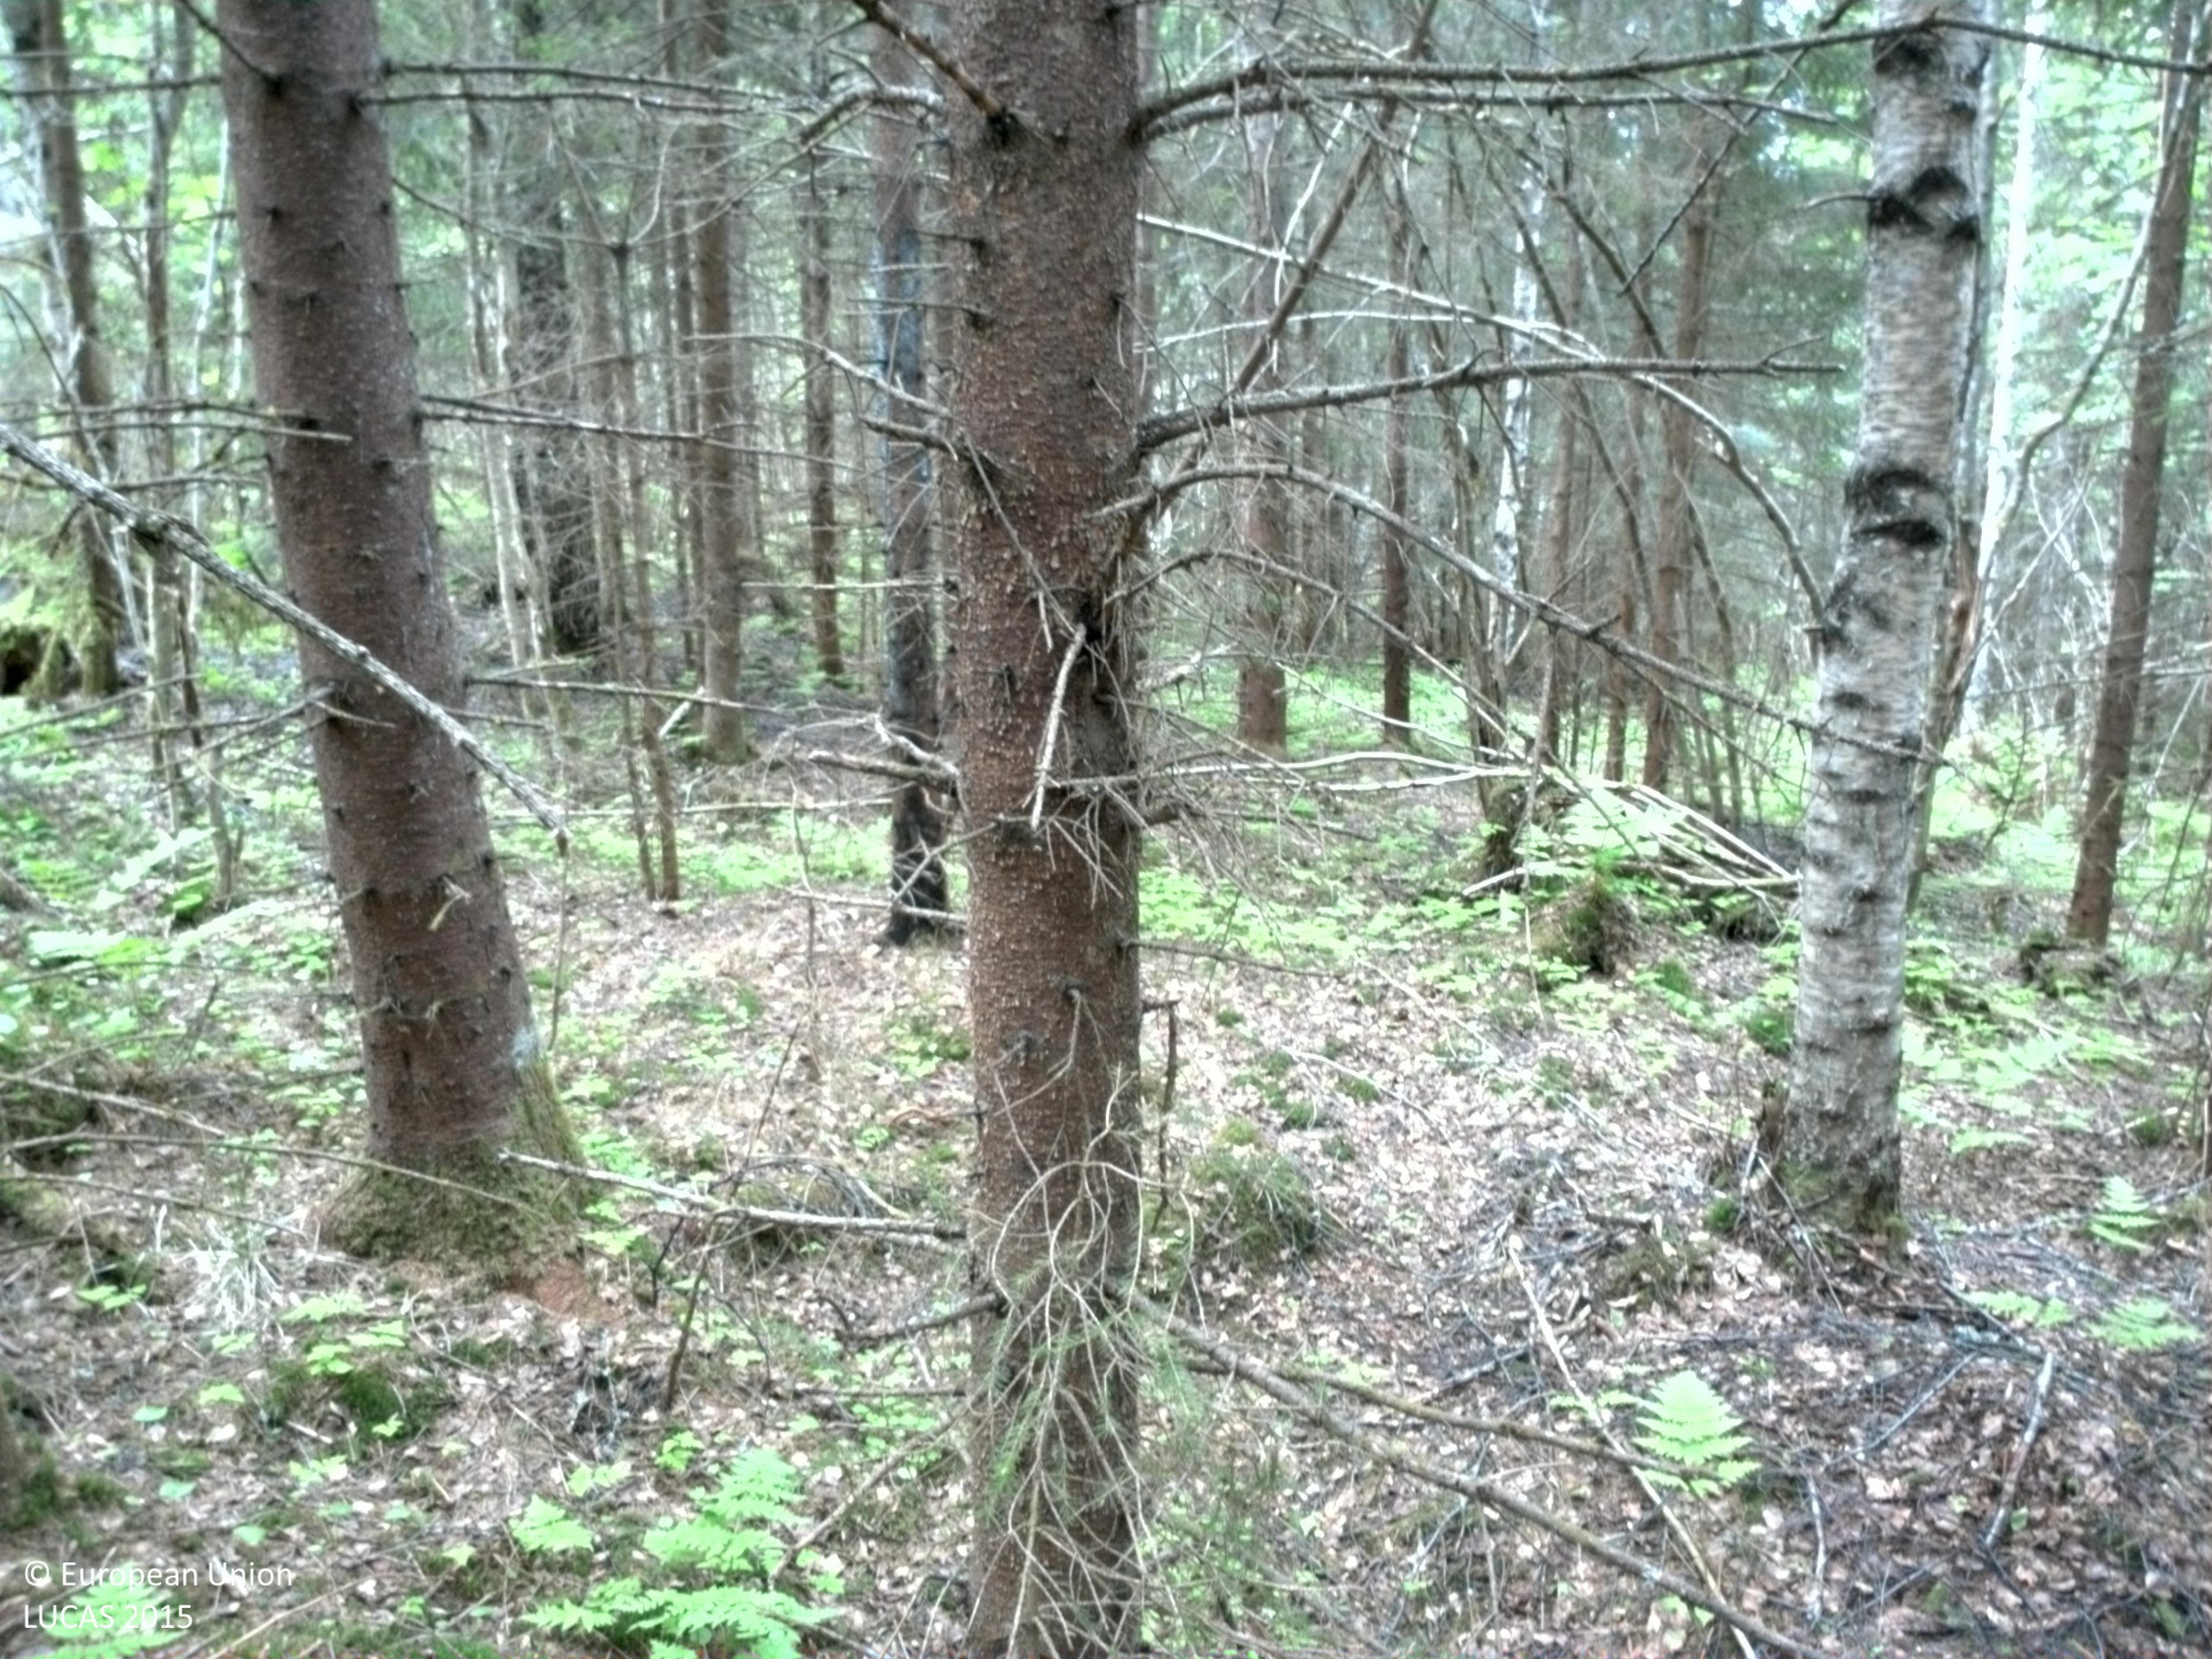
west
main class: Woodland
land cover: Spruce dominated coniferous woodland
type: boreal forest
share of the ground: > 75 %
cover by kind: coniferous forest trees 80 %, lichens and mosses 15 %, herbaceous plants 5 %
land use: Forestry
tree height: > 5 m
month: June
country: SE
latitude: 62.9438
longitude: 17.9987
